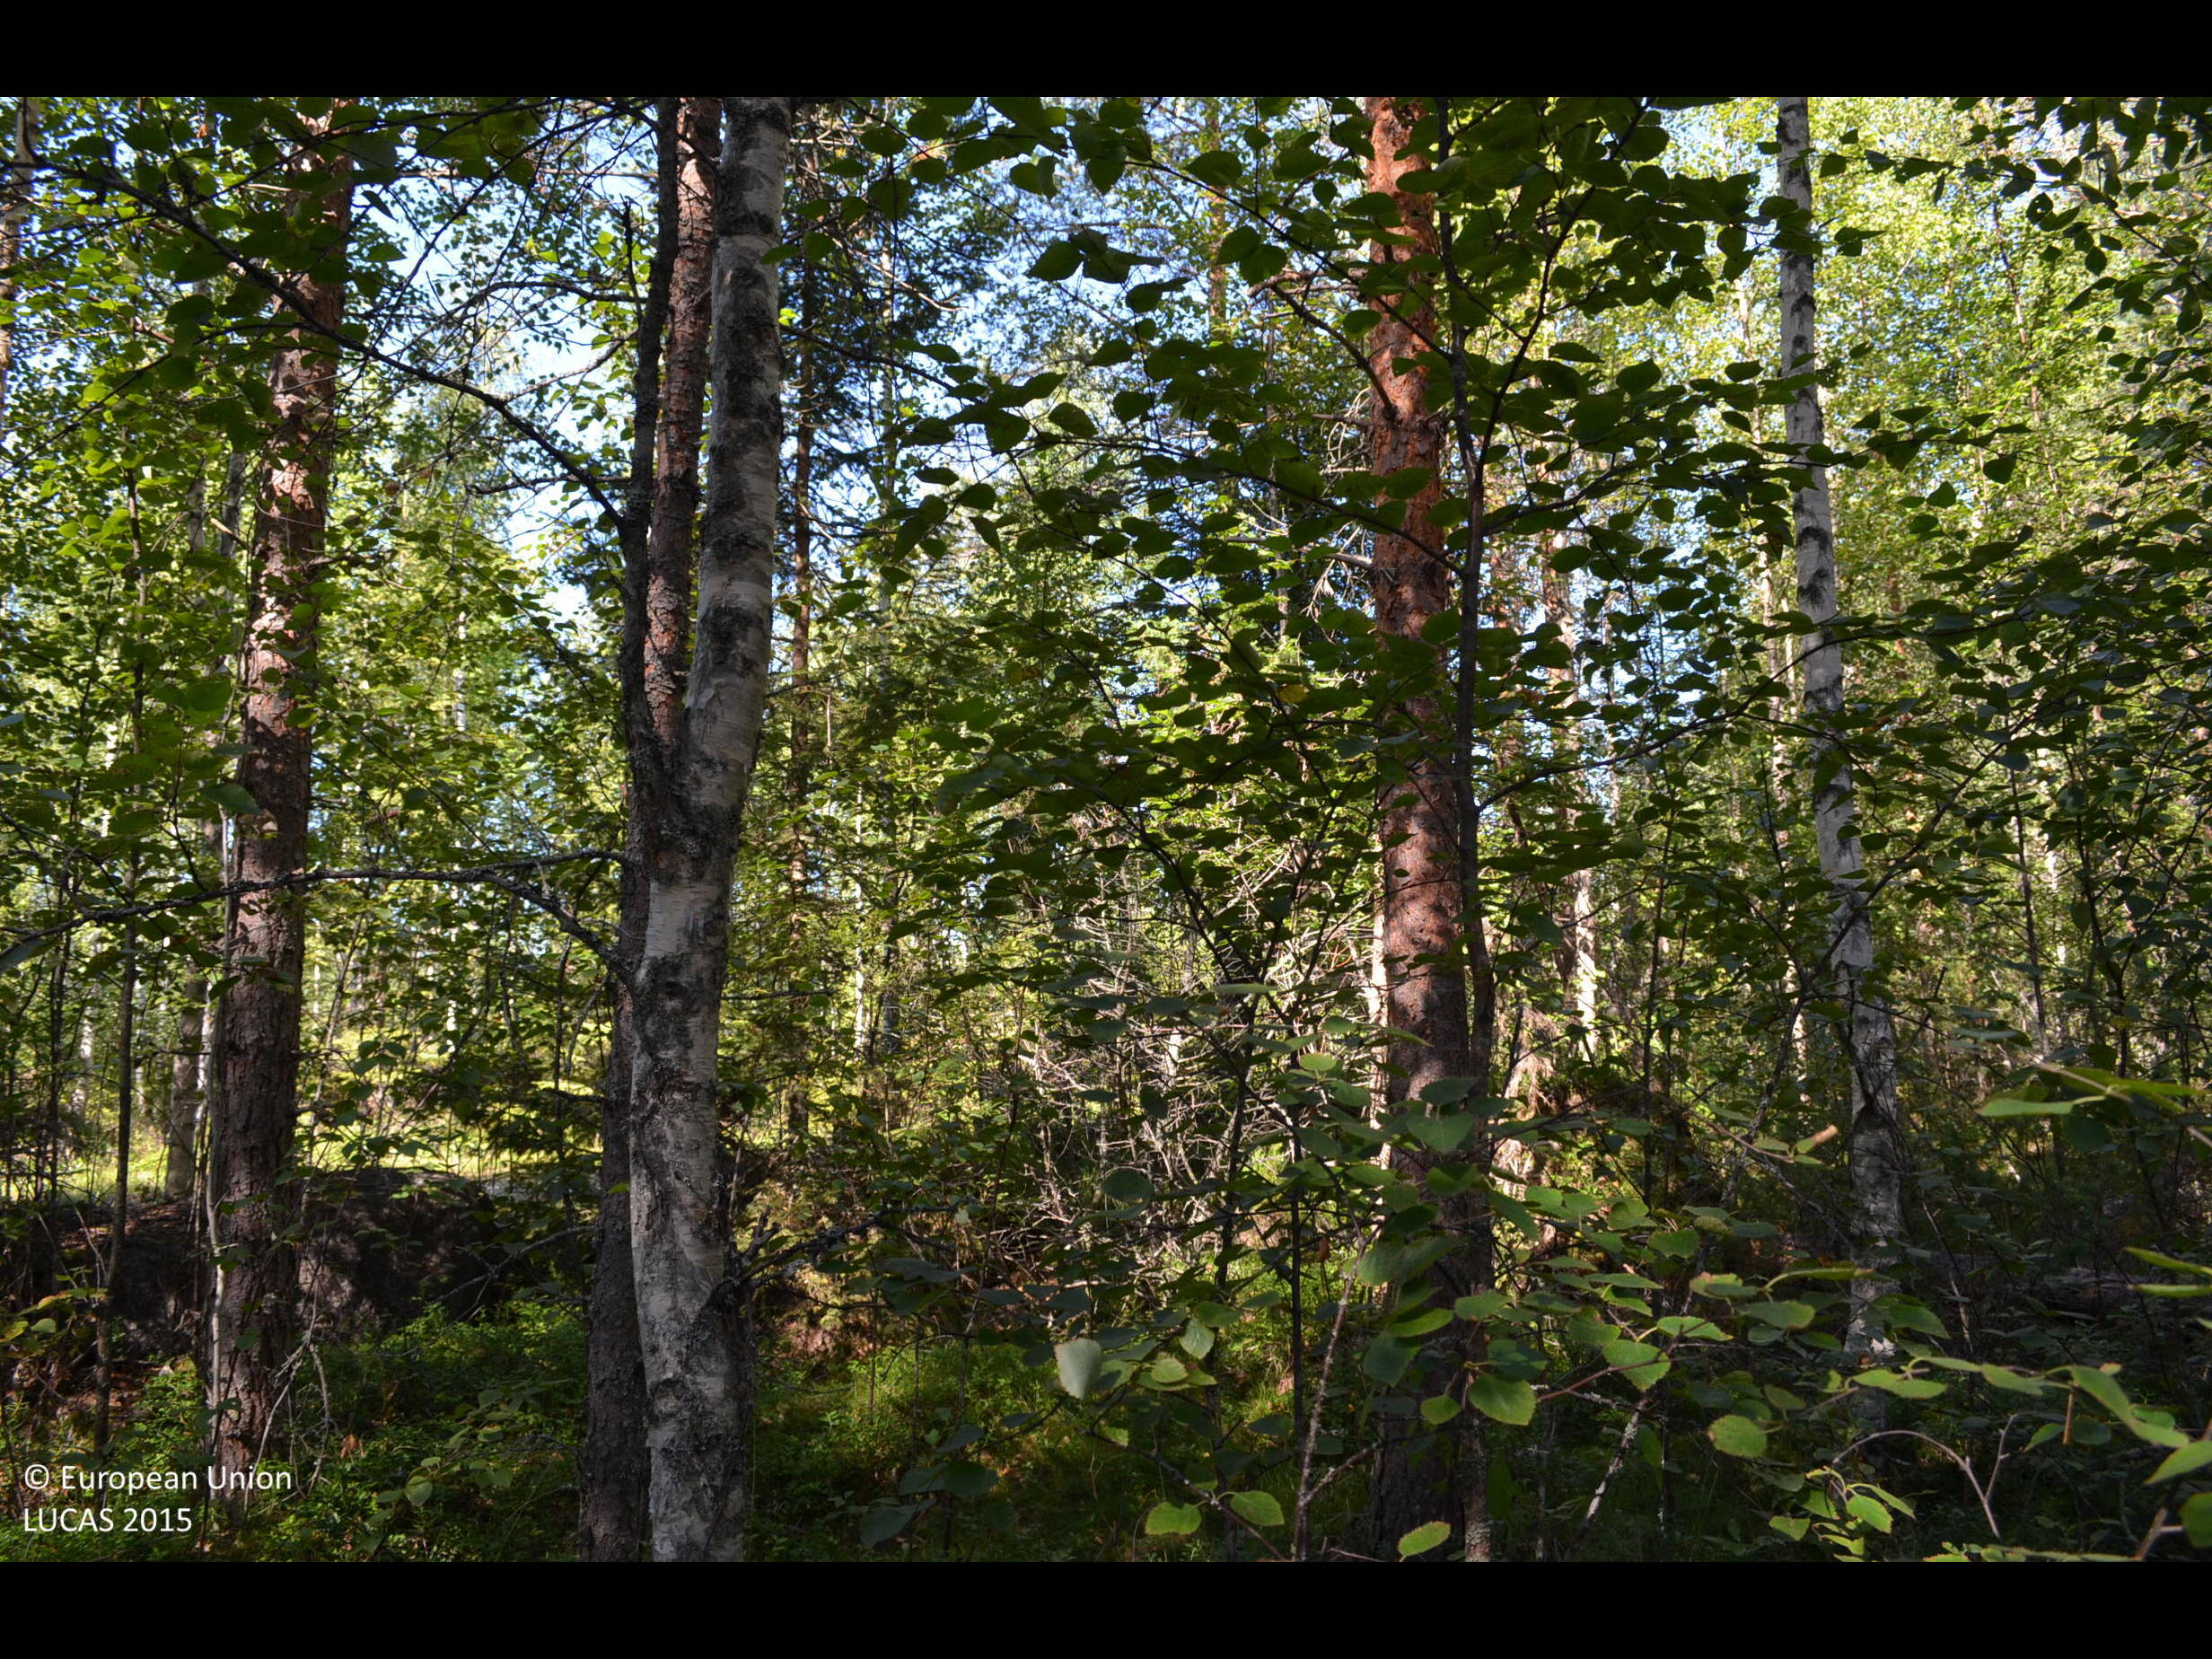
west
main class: Woodland
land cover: Pine dominated mixed woodland
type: boreal forest
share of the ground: > 75 %
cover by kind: coniferous forest trees 50 %, broadleaved forest trees 35 %, shrubs 15 %
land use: Forestry
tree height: > 5 m
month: August
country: FI
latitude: 62.2504
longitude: 24.3547
